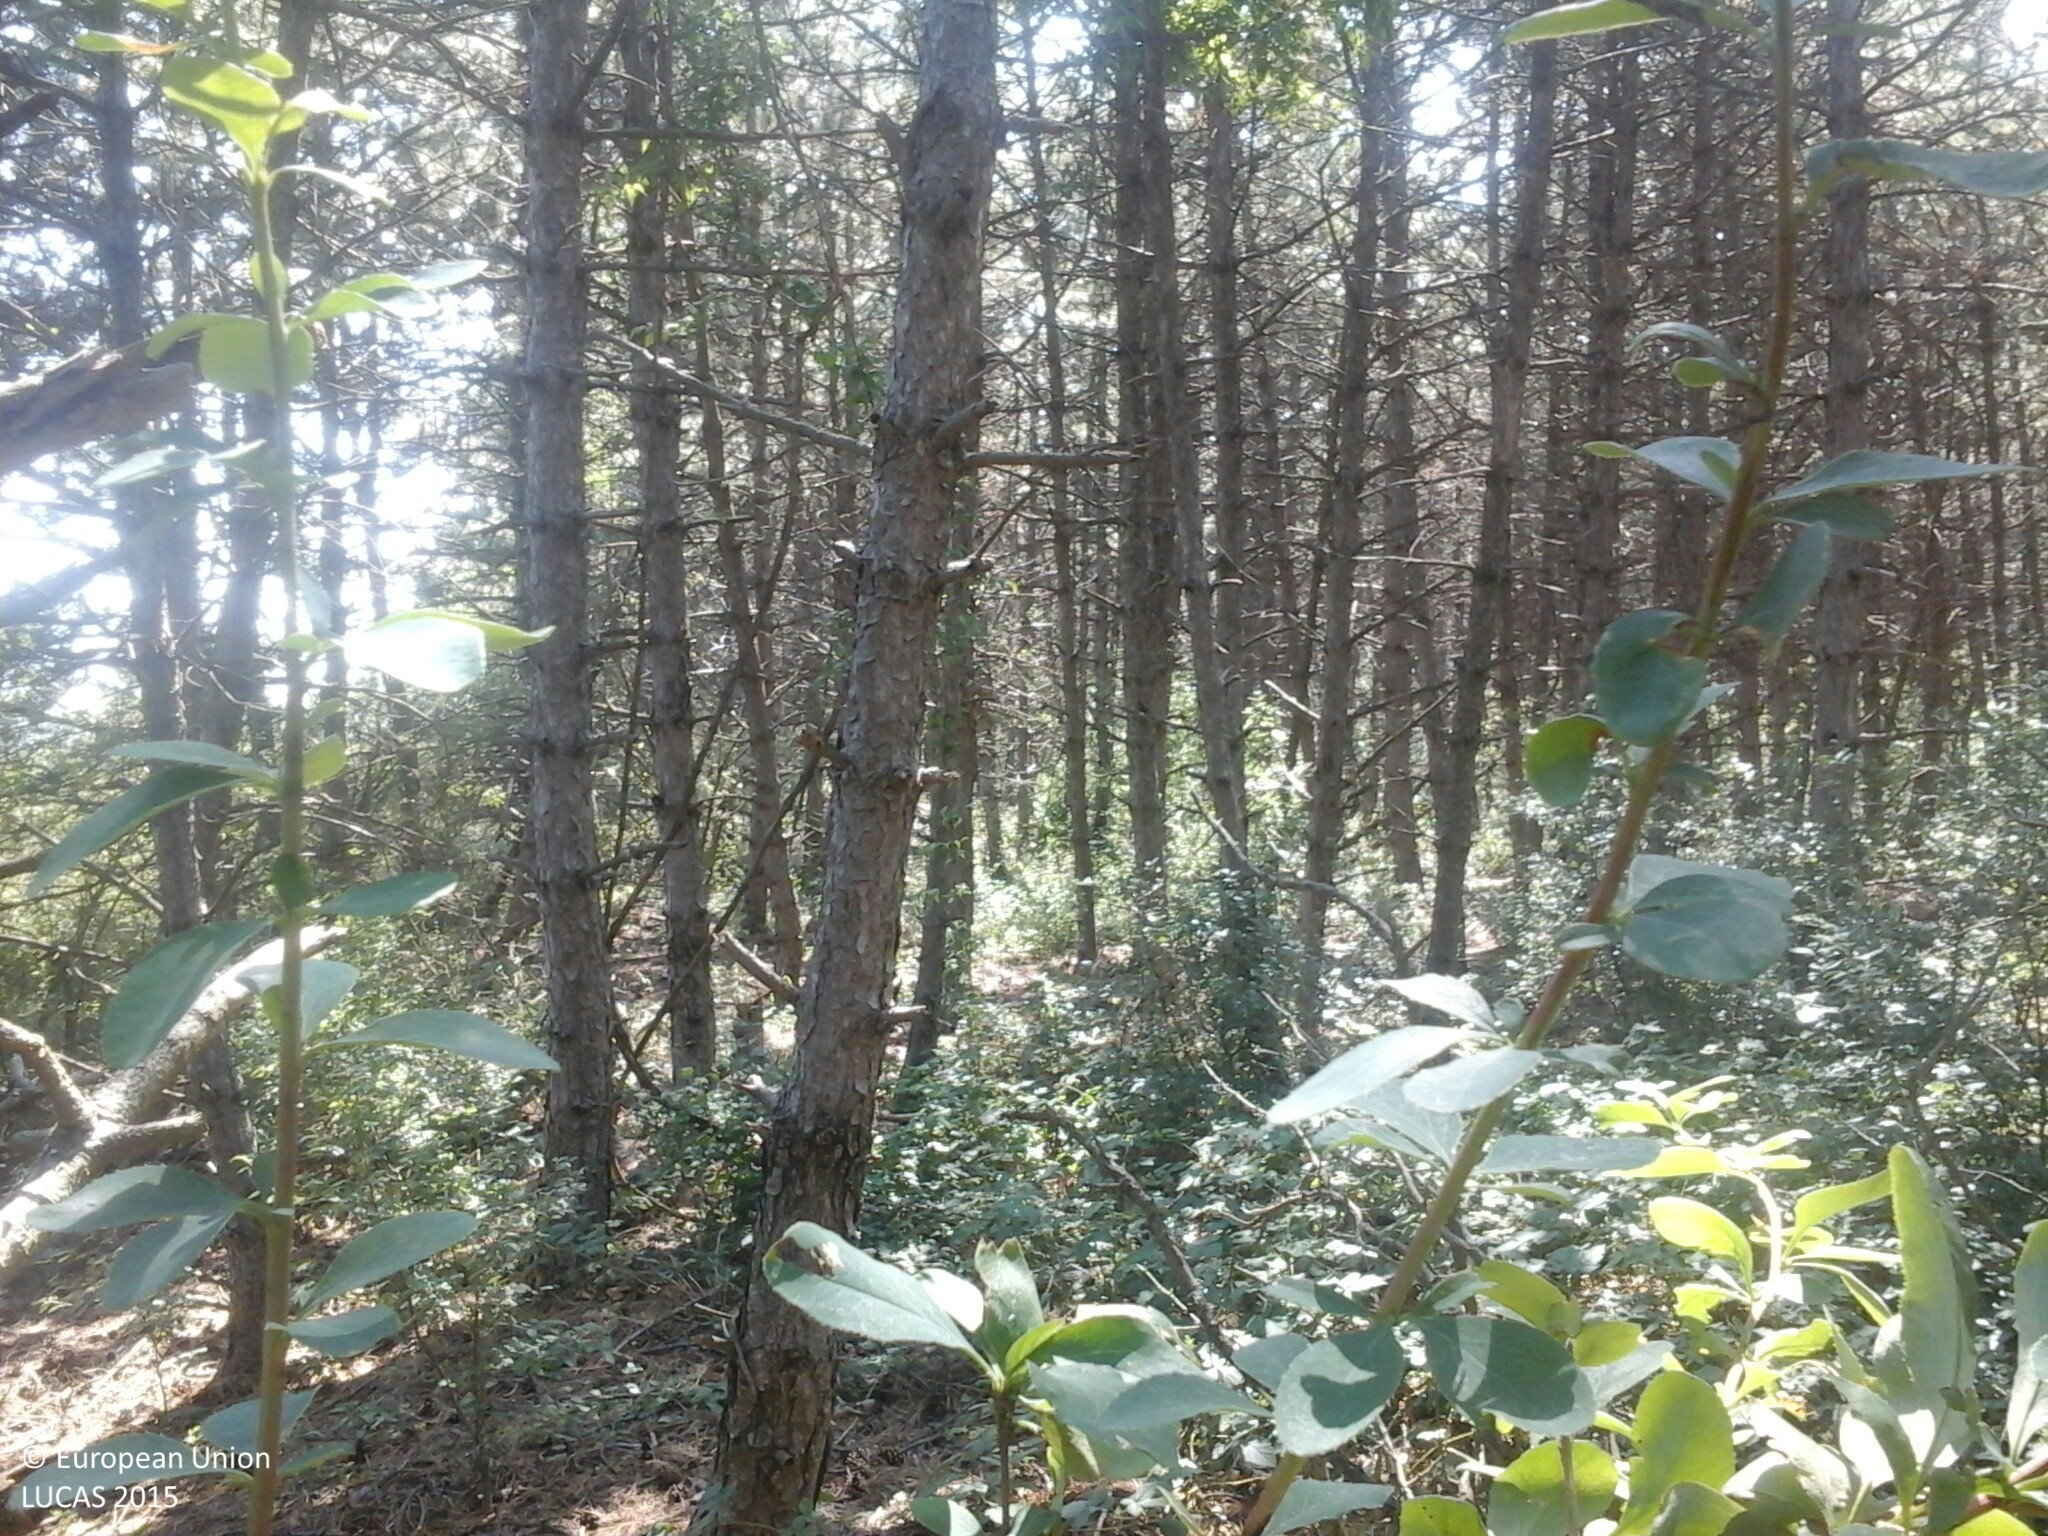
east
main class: Woodland
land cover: Other coniferous woodland
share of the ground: > 75 %
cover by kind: coniferous forest trees 70 %, shrubs 20 %, herbaceous plants 10 %
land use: Forestry
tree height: < 5 m
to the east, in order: Other coniferous woodland; Grassland with sparse tree/shrub cover; Tracks; Grassland with sparse tree/shrub cover; Tracks; Grassland without tree/shrub cover; Tracks; Grassland without tree/shrub cover; Tracks; Grassland without tree/shrub cover; Electric lines; Grassland without tree/shrub cover
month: July
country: HU
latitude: 47.2154
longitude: 18.1577
